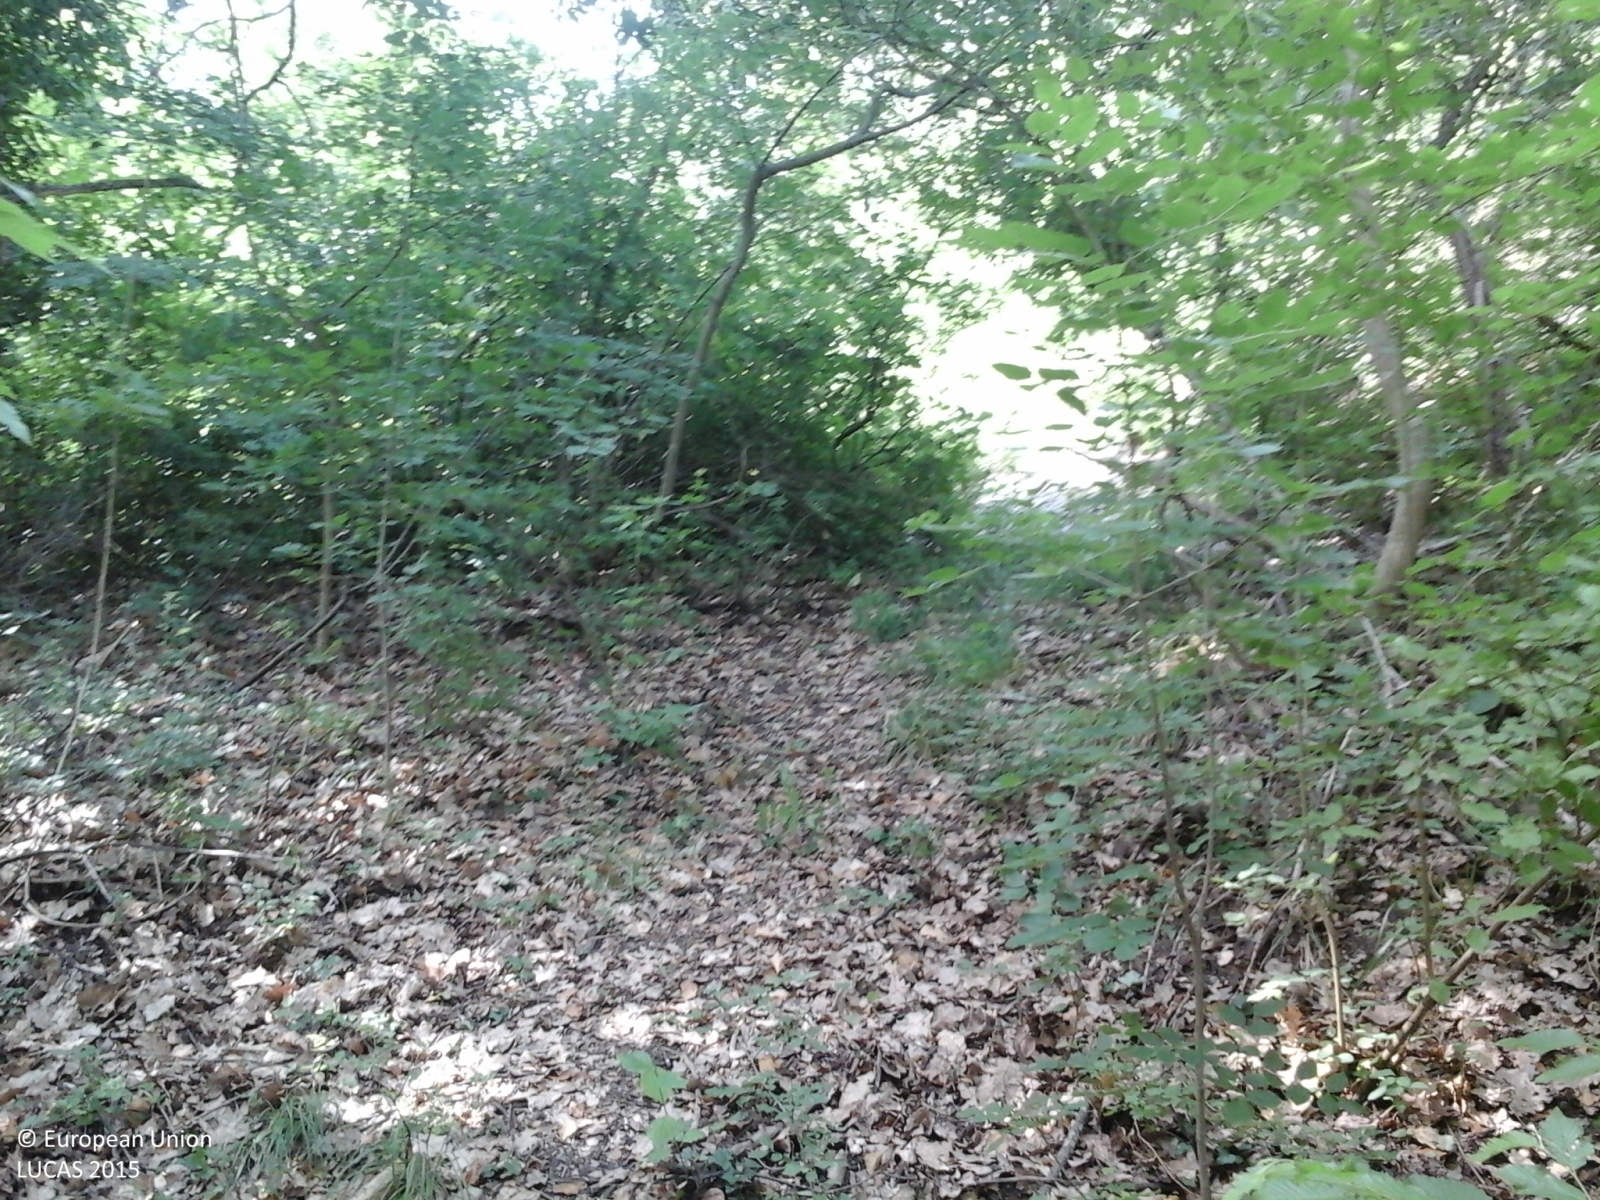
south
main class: Woodland
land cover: Broadleaved woodland
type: thermophilous deciduous forest
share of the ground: > 75 %
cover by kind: broadleaved forest trees 90 %, shrubs 10 %
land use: Forestry
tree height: > 5 m
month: June
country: IT
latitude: 44.2655
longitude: 11.6373
